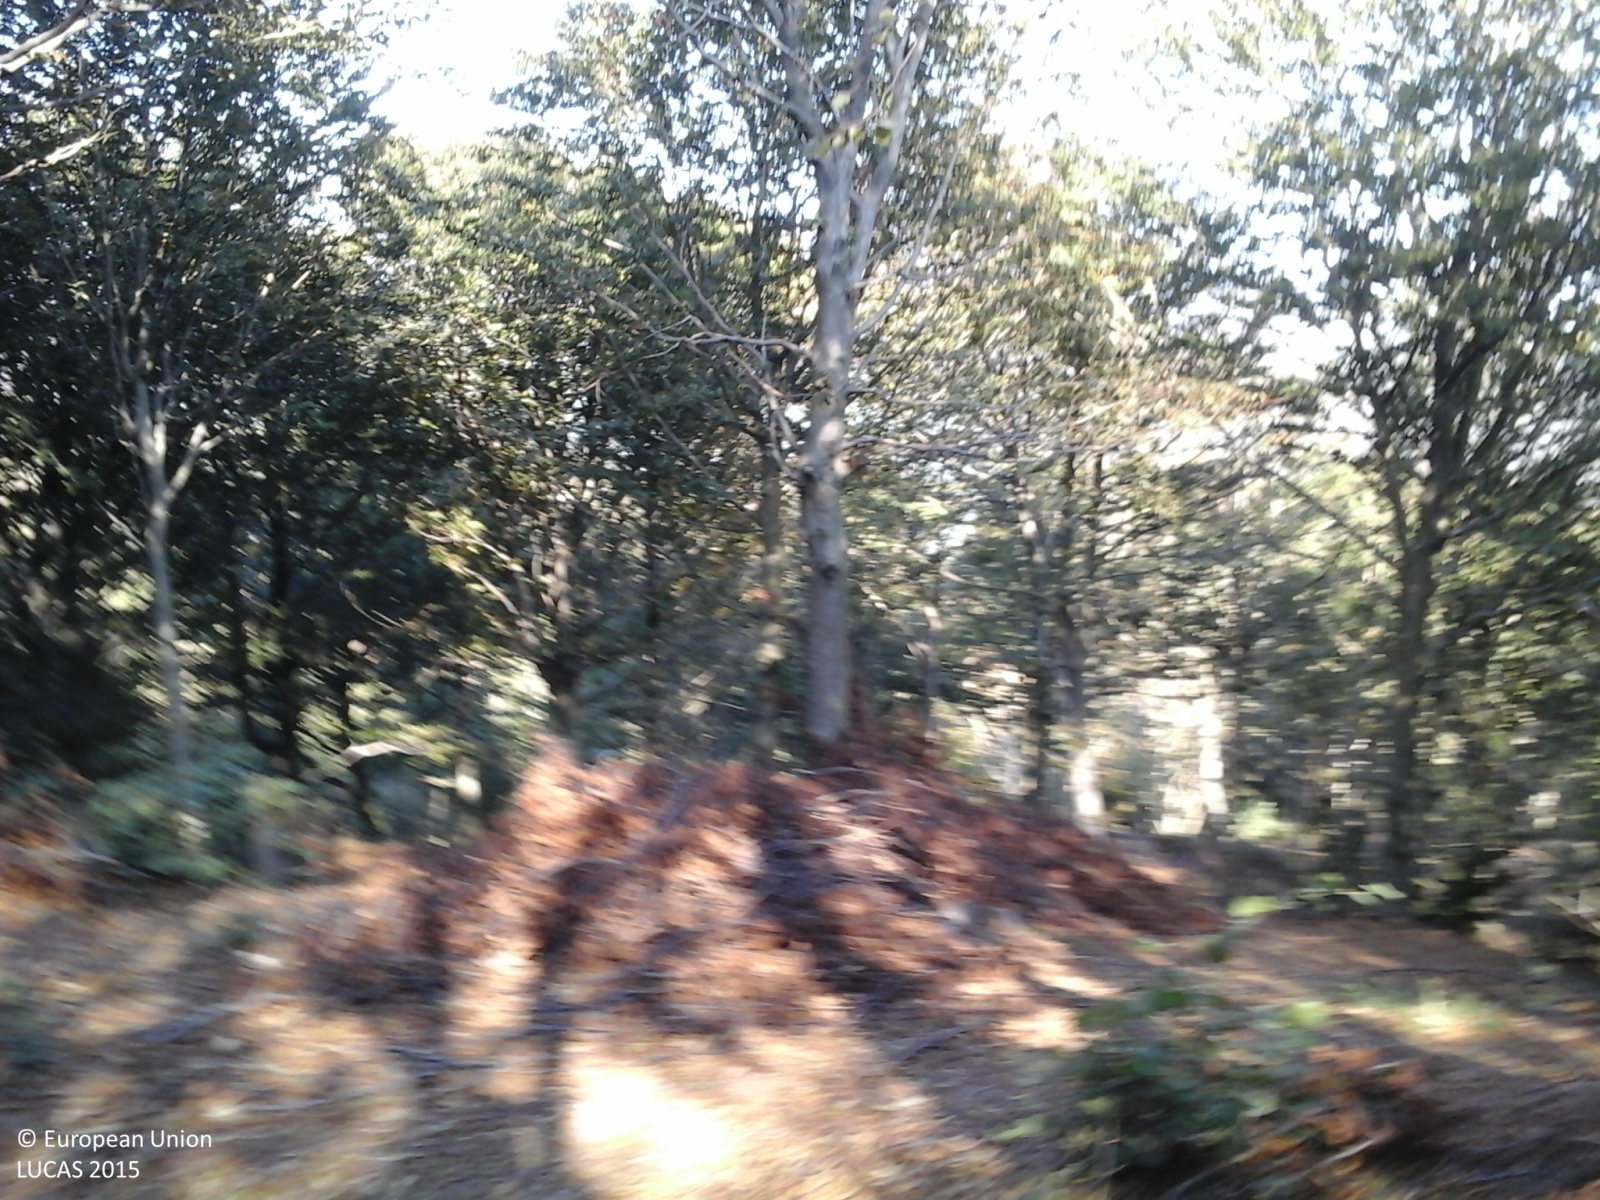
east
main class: Woodland
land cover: Broadleaved woodland
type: beech forest
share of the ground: > 75 %
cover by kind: broadleaved forest trees 100 %
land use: Forestry
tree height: > 5 m
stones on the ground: 25 - 50 %
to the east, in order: Broadleaved woodland; Tracks; Broadleaved woodland
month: September
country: IT
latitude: 44.4113
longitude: 8.4588
